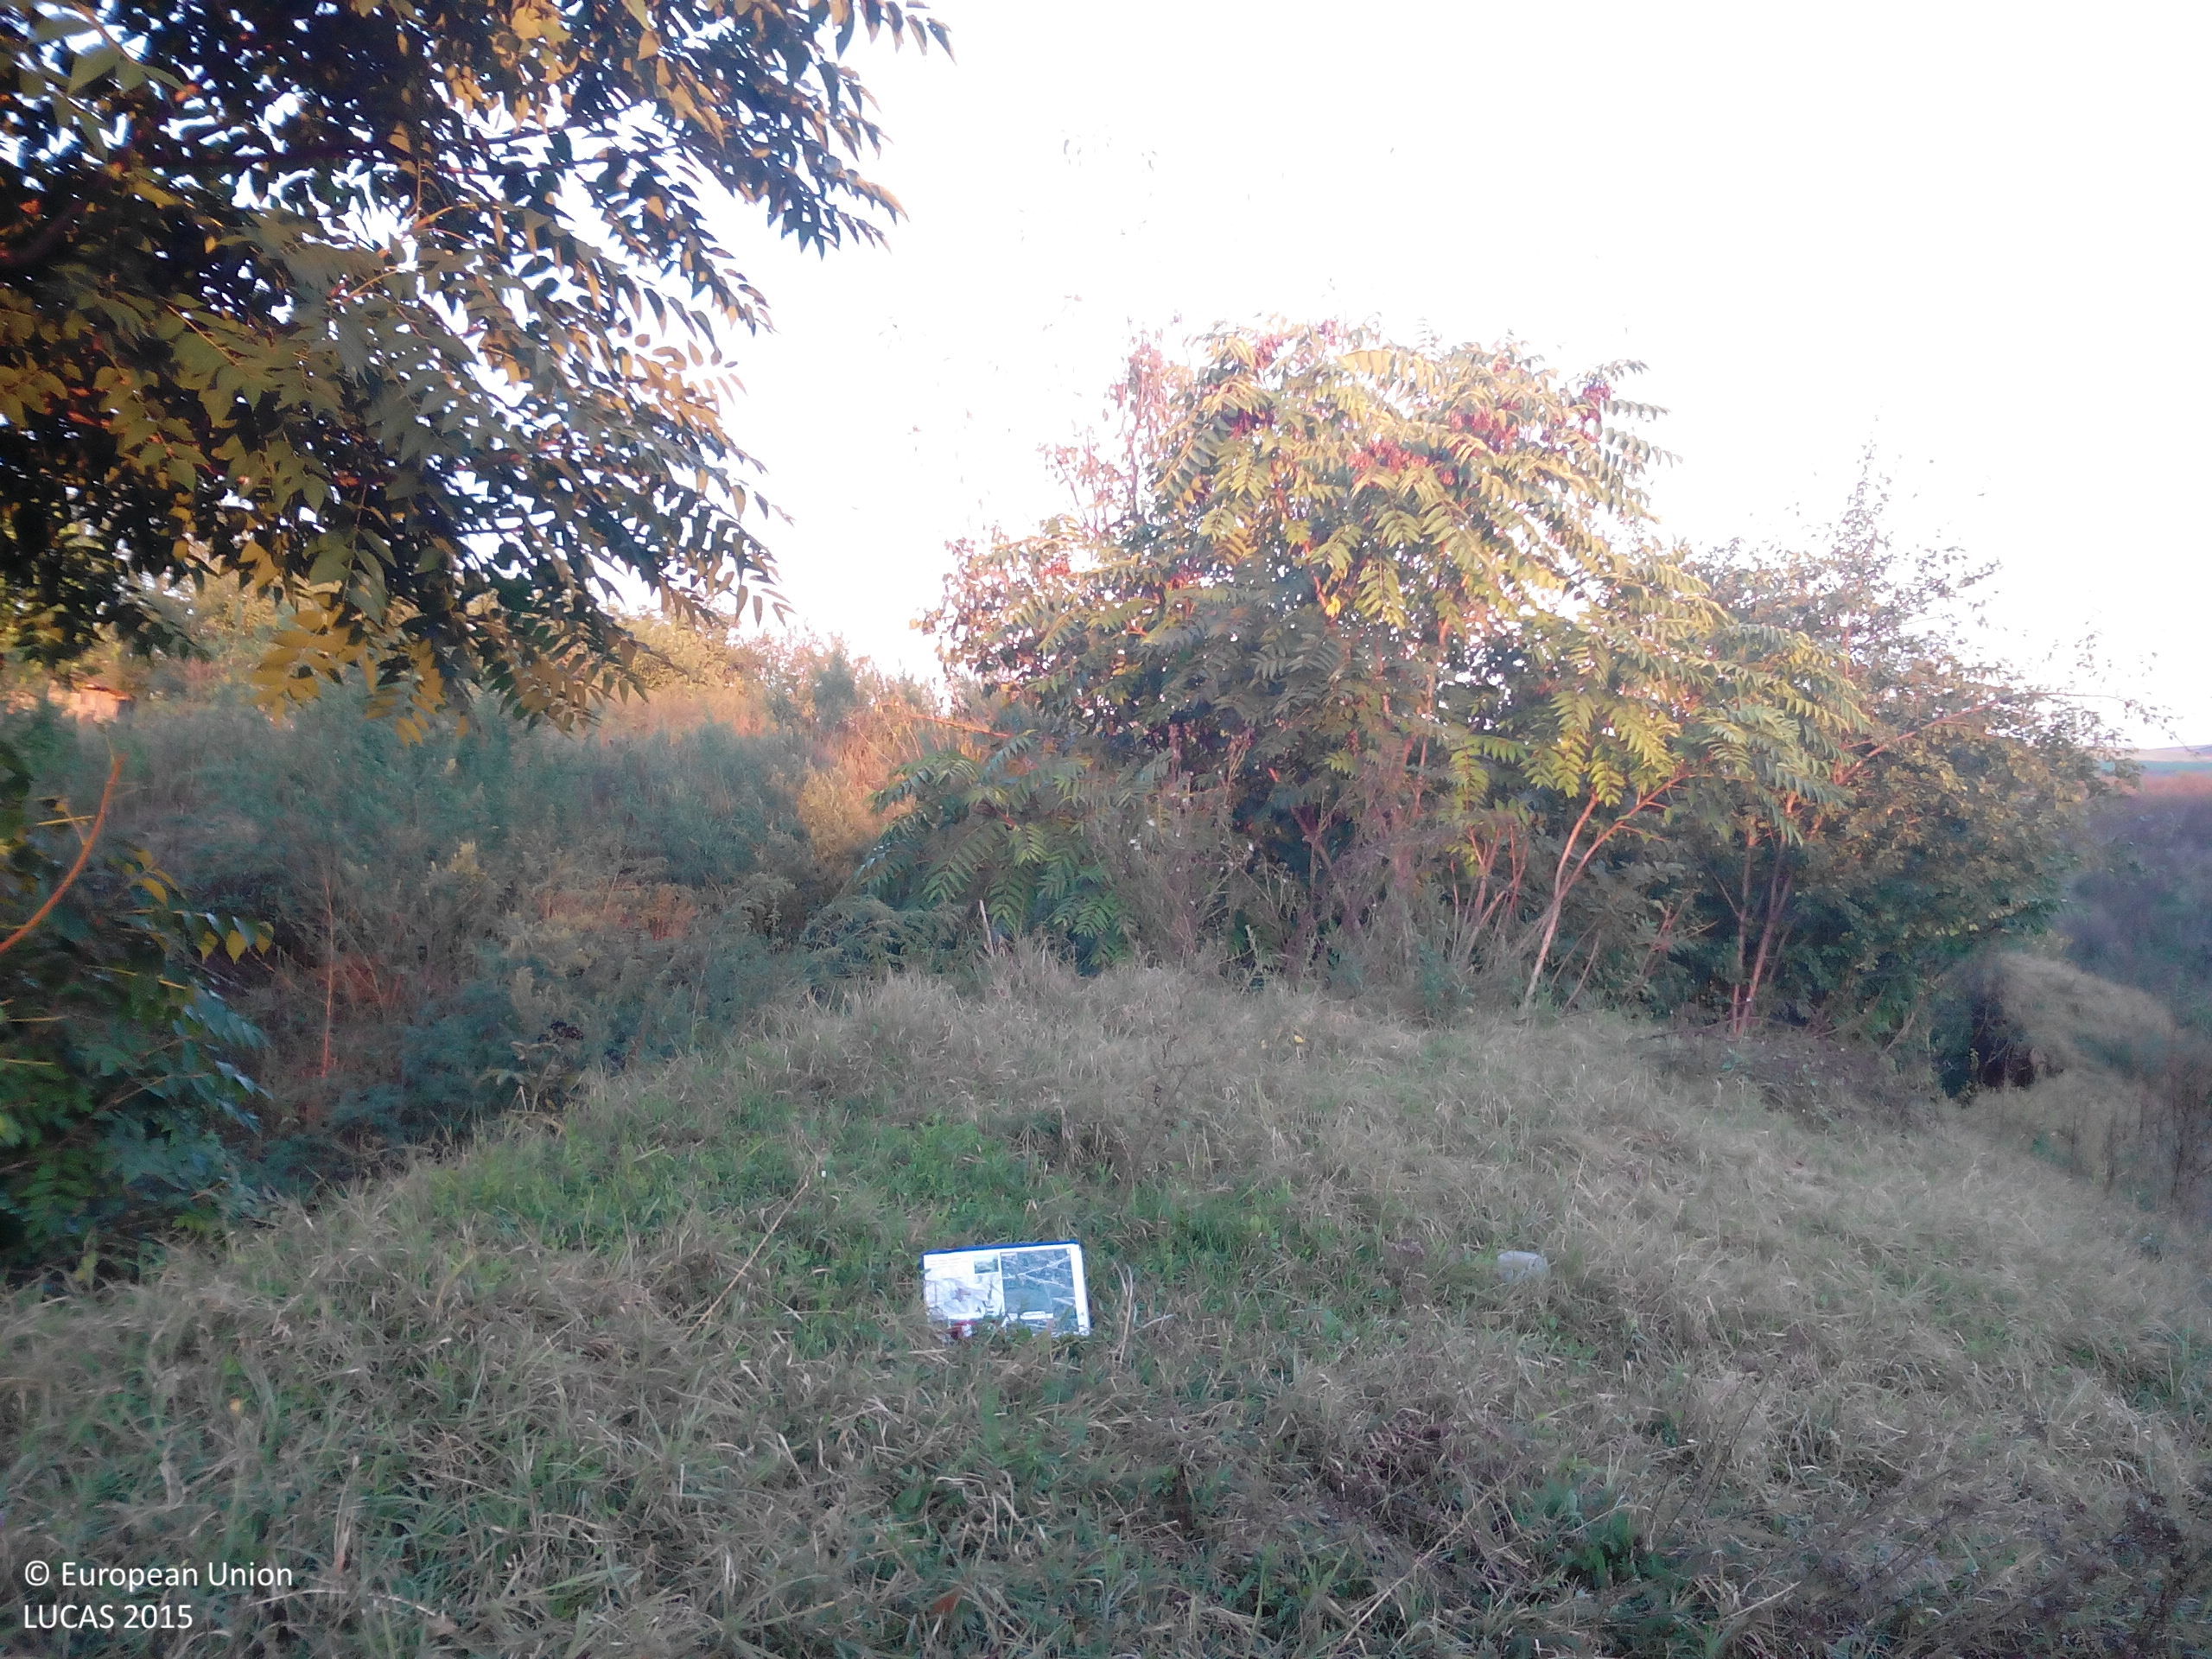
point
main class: Woodland
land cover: Broadleaved woodland
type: mesophytic deciduous forest
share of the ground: 25 - 50 %
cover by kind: herbaceous plants 60 %, broadleaved forest trees 30 %, shrubs 10 %
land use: Semi-natural and natural areas not in use
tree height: > 5 m
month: October
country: BG
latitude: 43.5589
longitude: 23.8792
